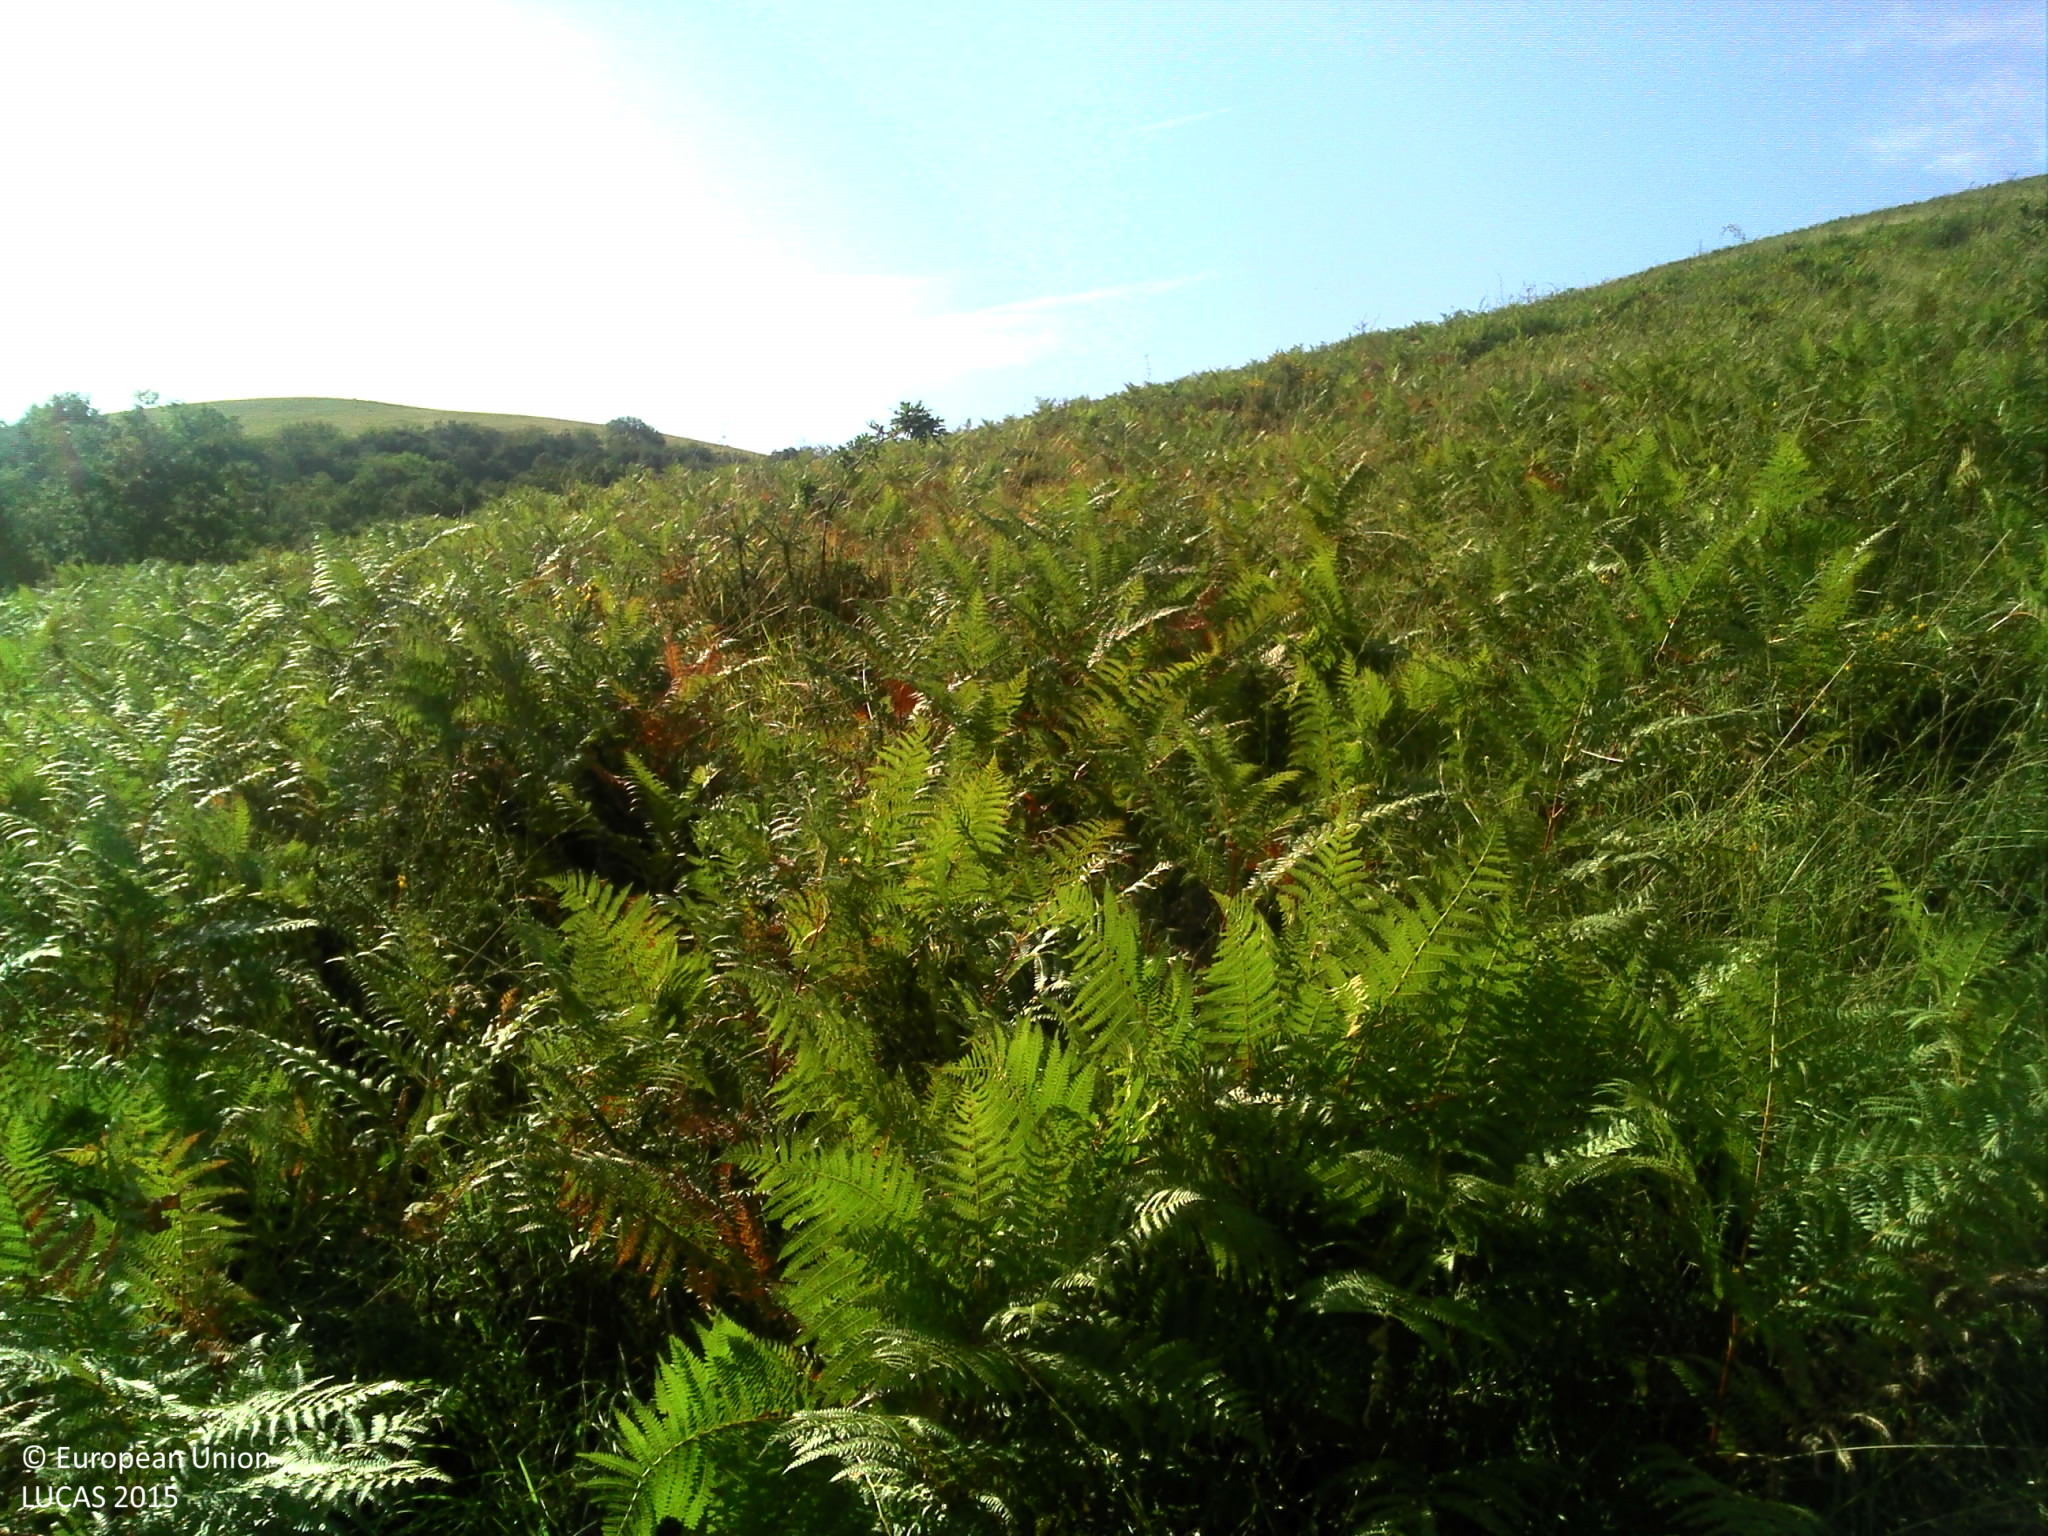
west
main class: Grassland
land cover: Grassland without tree/shrub cover
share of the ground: > 75 %
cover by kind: herbaceous plants 90 %, shrubs 5 %, consolidated bare surface 5 %
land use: Agriculture (excluding fallow land and kitchen gardens)
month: September
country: FR
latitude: 43.1919
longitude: -1.0743
